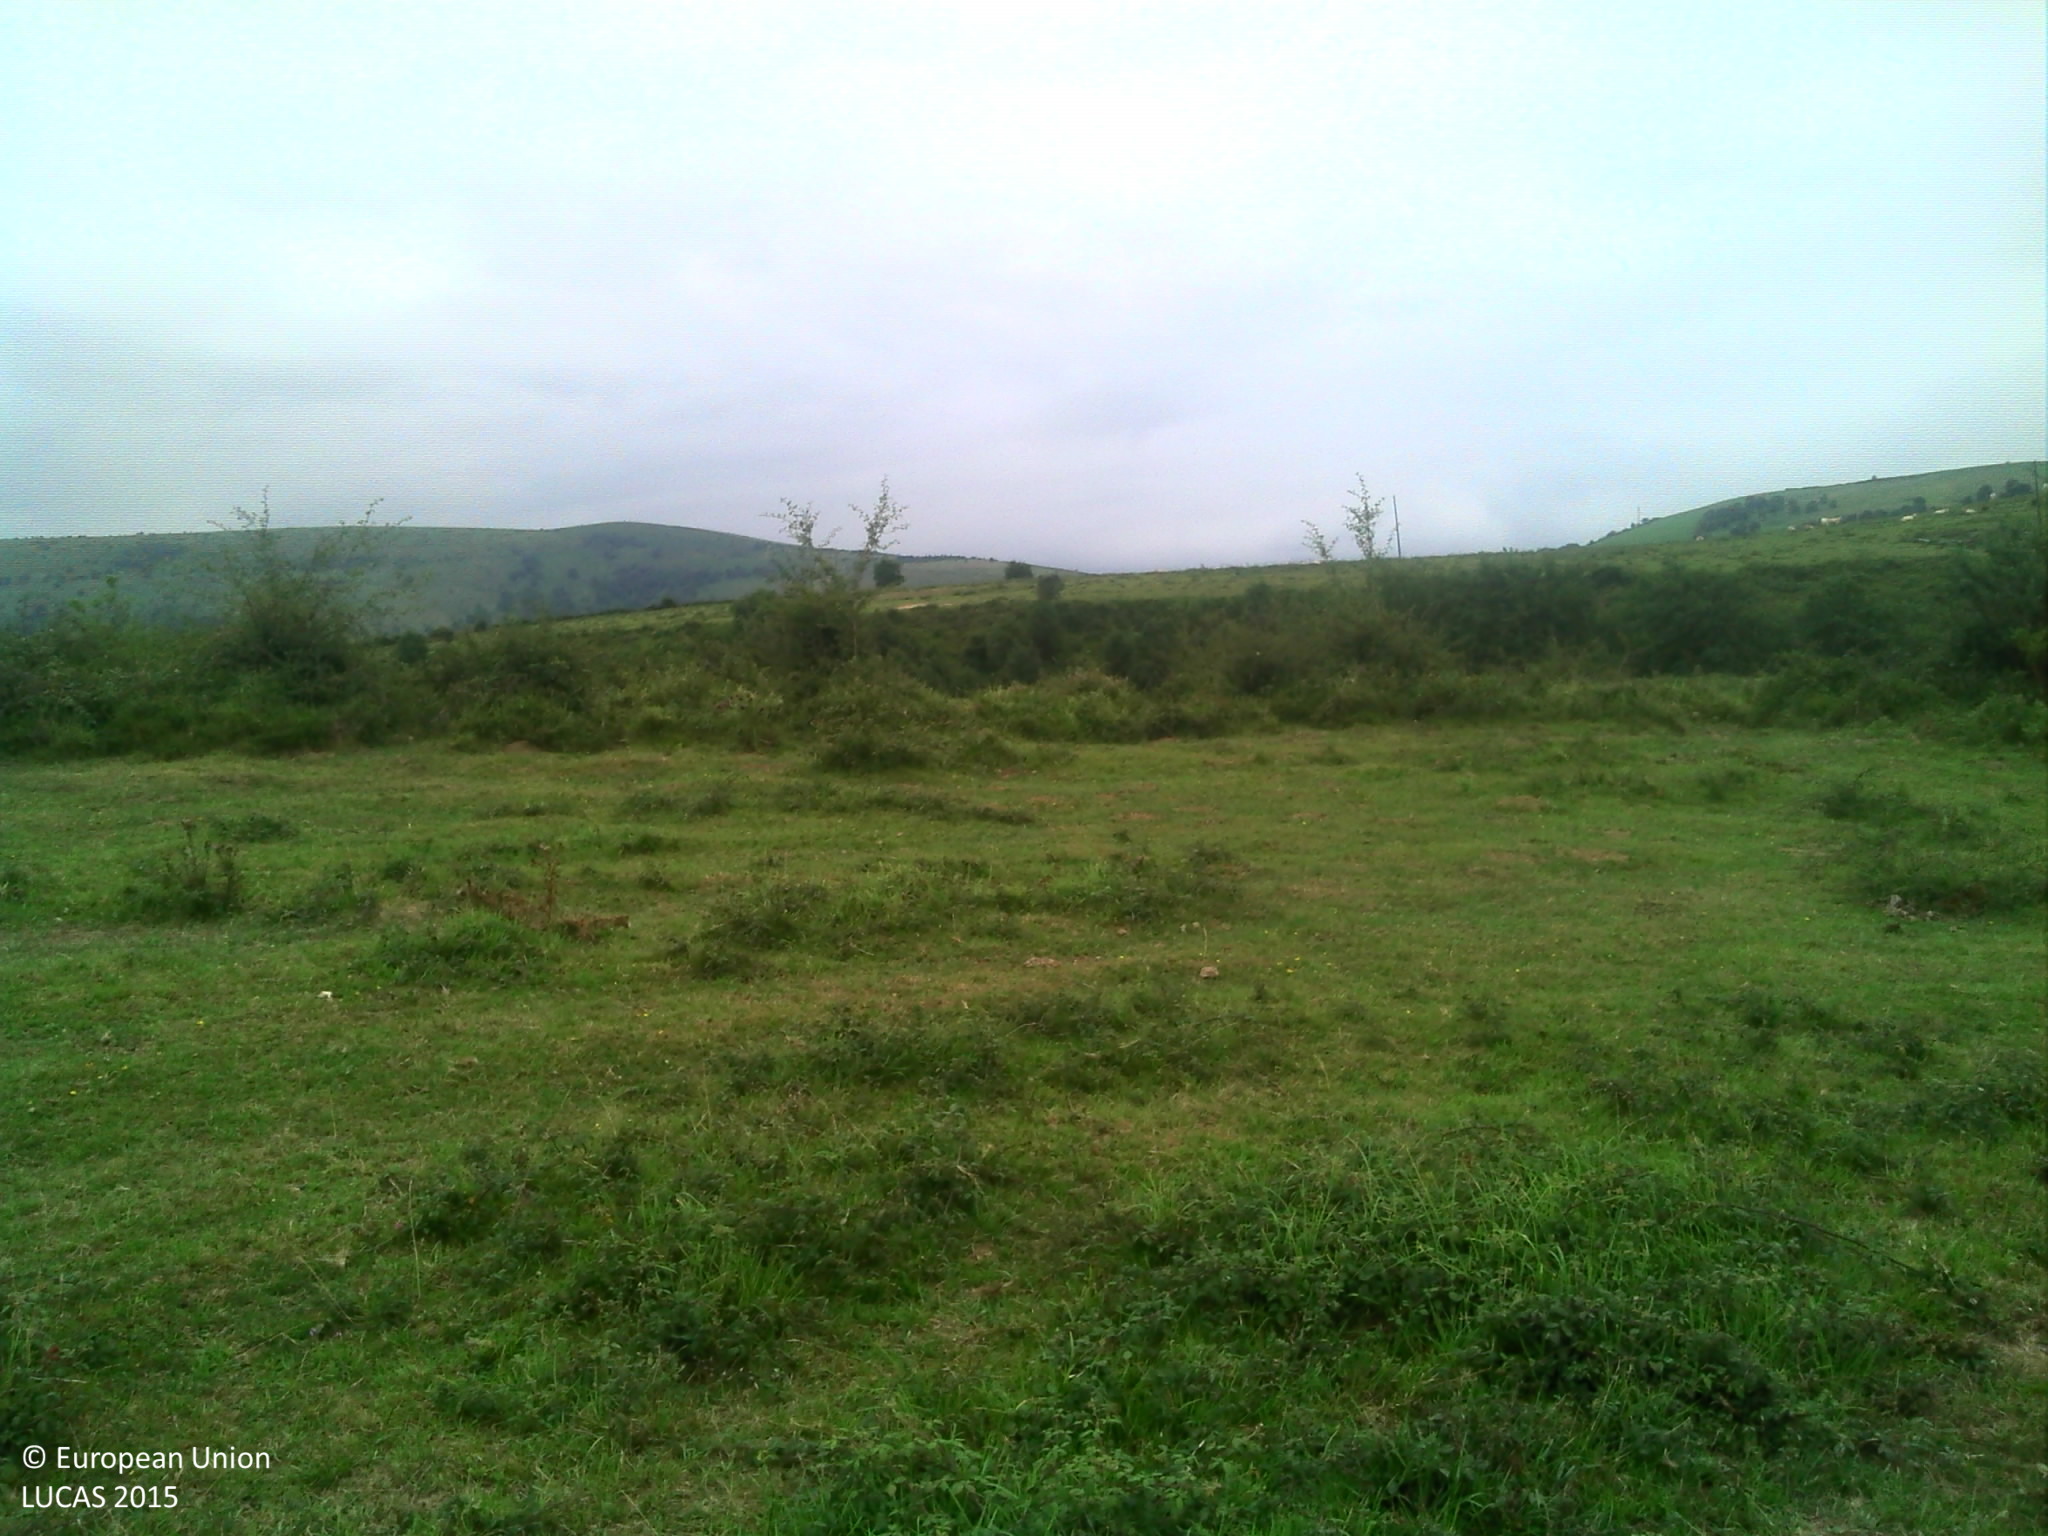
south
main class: Grassland
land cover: Grassland without tree/shrub cover
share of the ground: > 75 %
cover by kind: herbaceous plants 95 %, shrubs 5 %
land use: Agriculture (excluding fallow land and kitchen gardens)
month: August
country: FR
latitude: 43.2552
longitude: -1.1610
